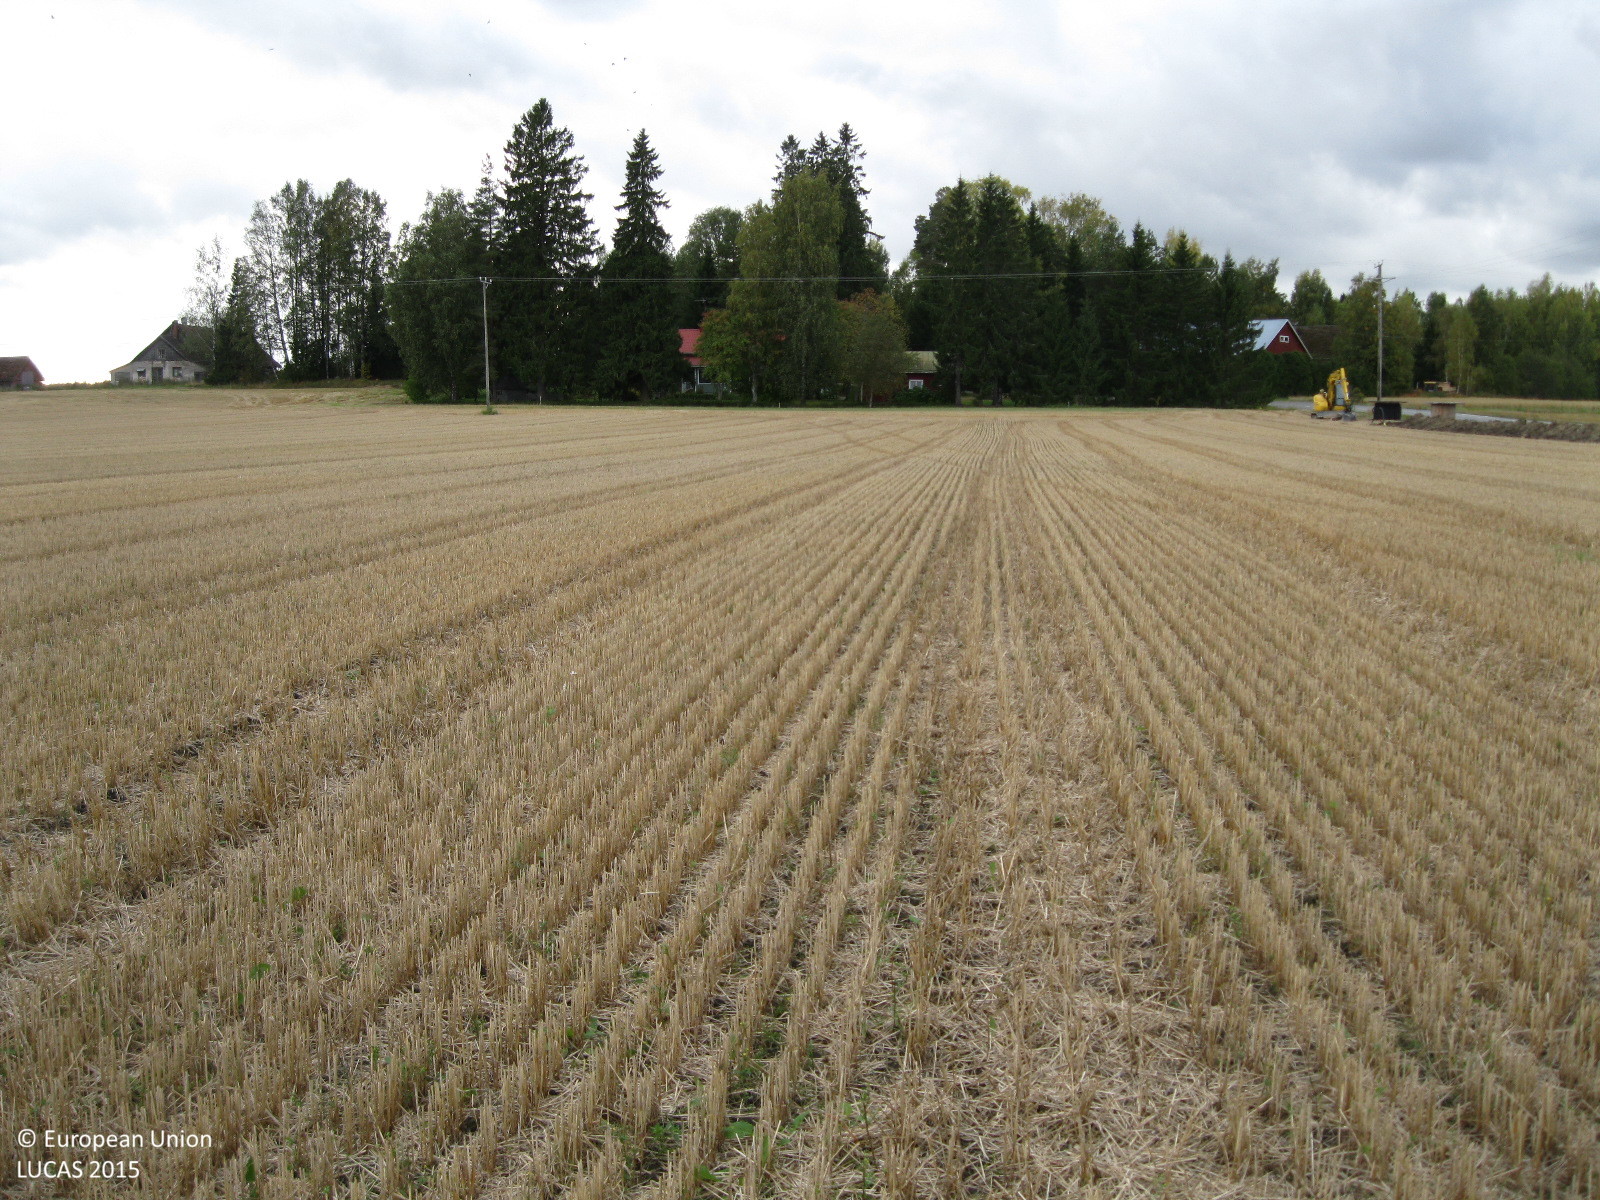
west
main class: Cropland
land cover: Barley
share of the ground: > 75 %
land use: Agriculture (excluding fallow land and kitchen gardens)
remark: Harvested field
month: September
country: FI
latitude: 60.6746
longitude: 24.8473
